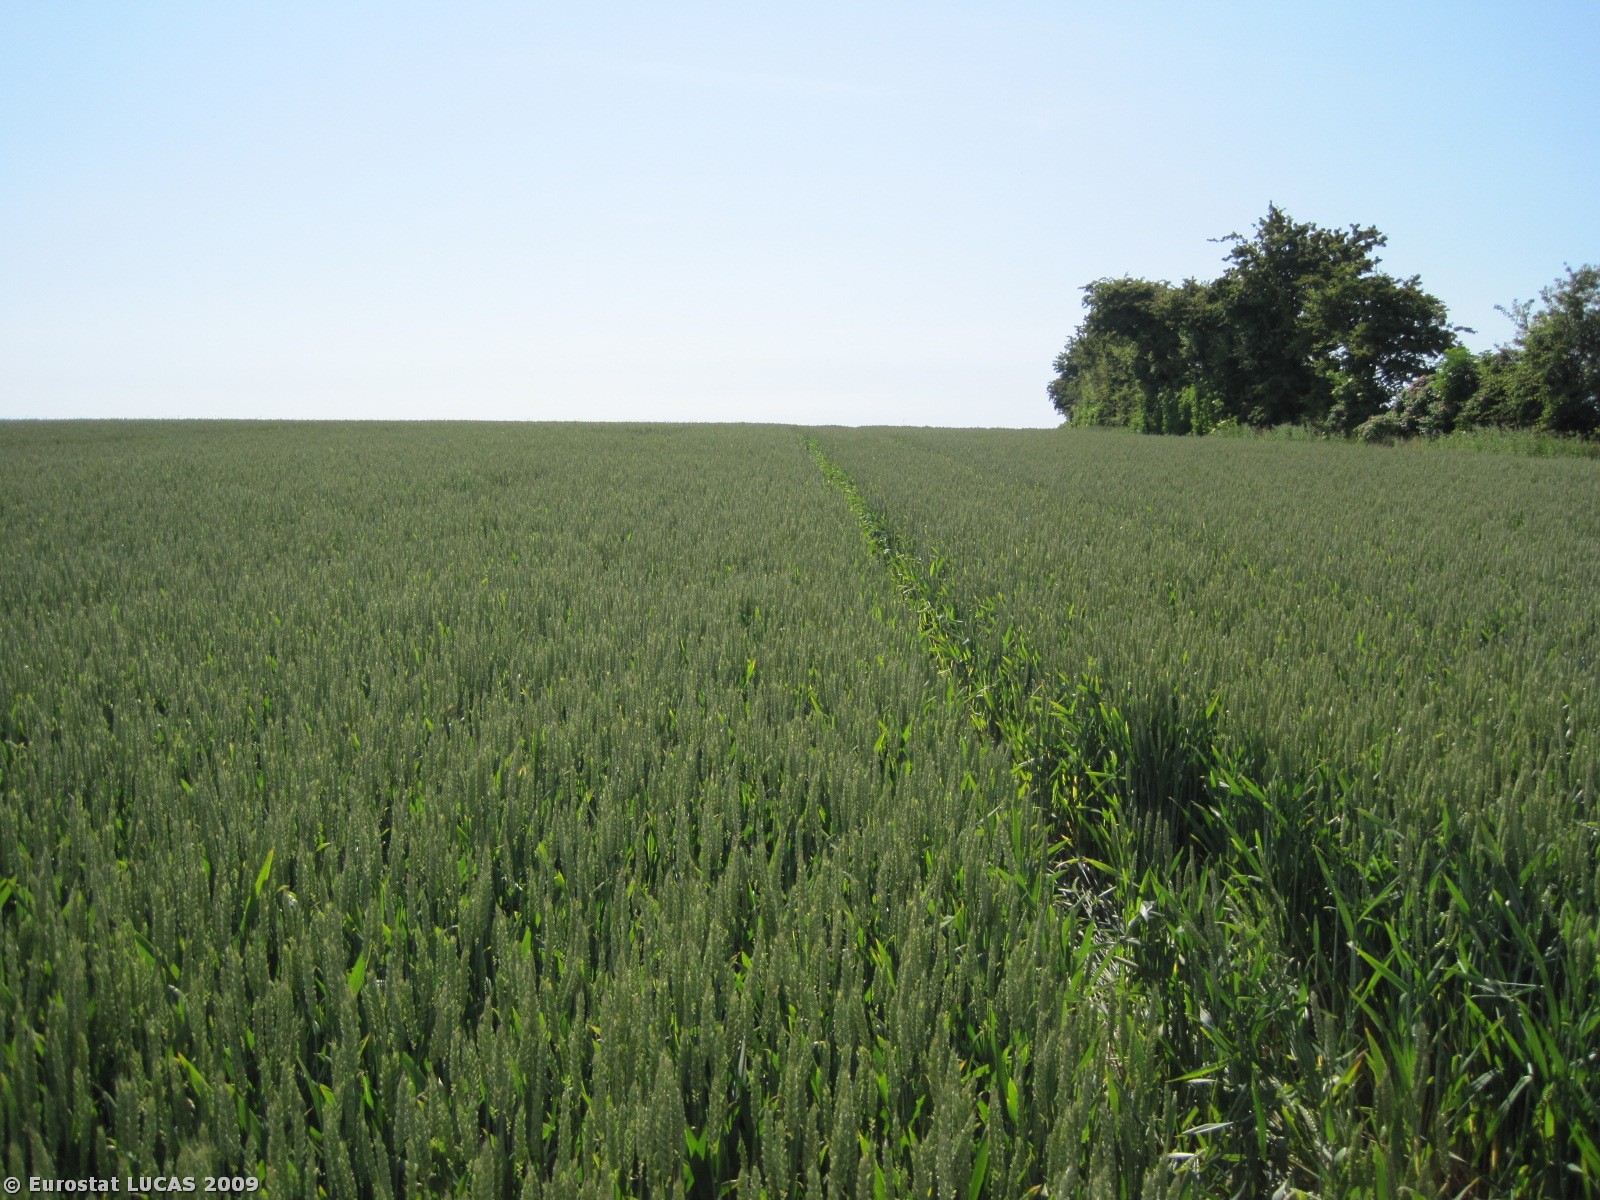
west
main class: Cropland
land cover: Common wheat
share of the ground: > 75 %
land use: Agriculture (excluding fallow land and kitchen gardens)
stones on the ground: < 10 %
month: June
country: DK
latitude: 56.5971
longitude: 8.9753
